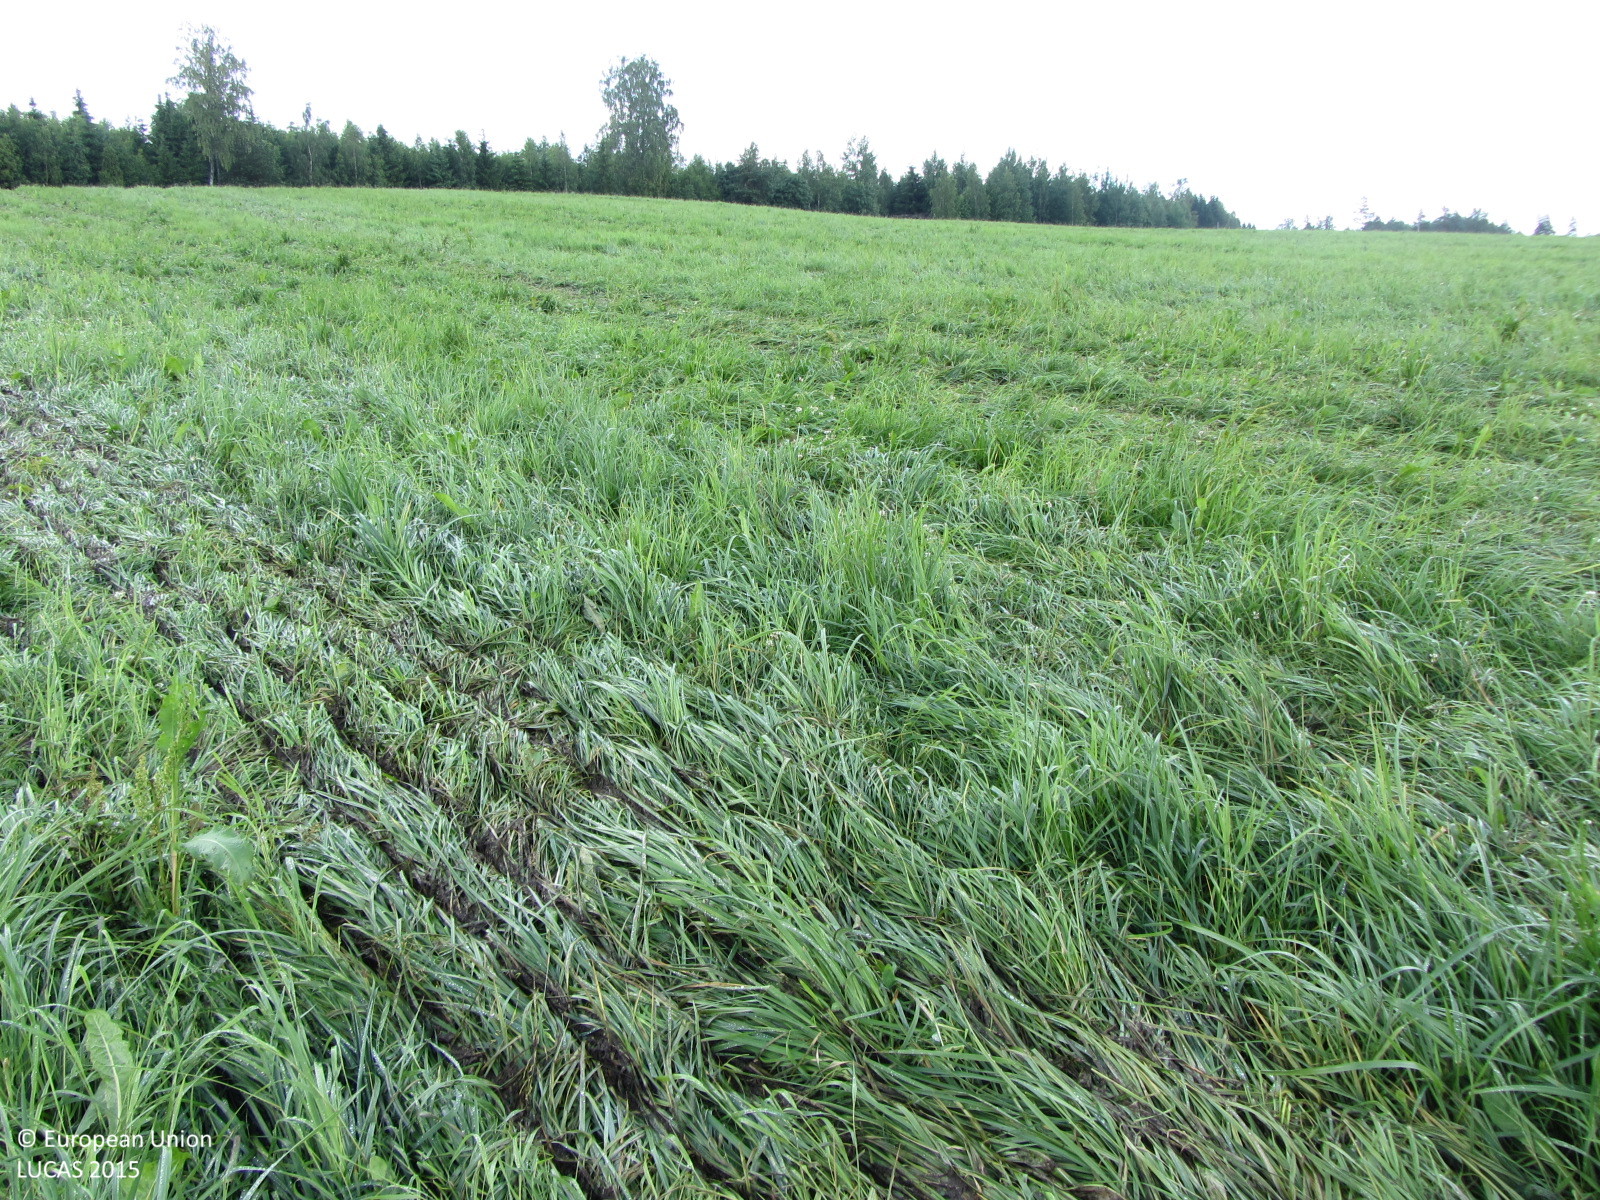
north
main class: Grassland
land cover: Grassland without tree/shrub cover
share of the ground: > 75 %
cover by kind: herbaceous plants 100 %
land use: Agriculture (excluding fallow land and kitchen gardens)
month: July
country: FI
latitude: 60.0495
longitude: 23.2111
